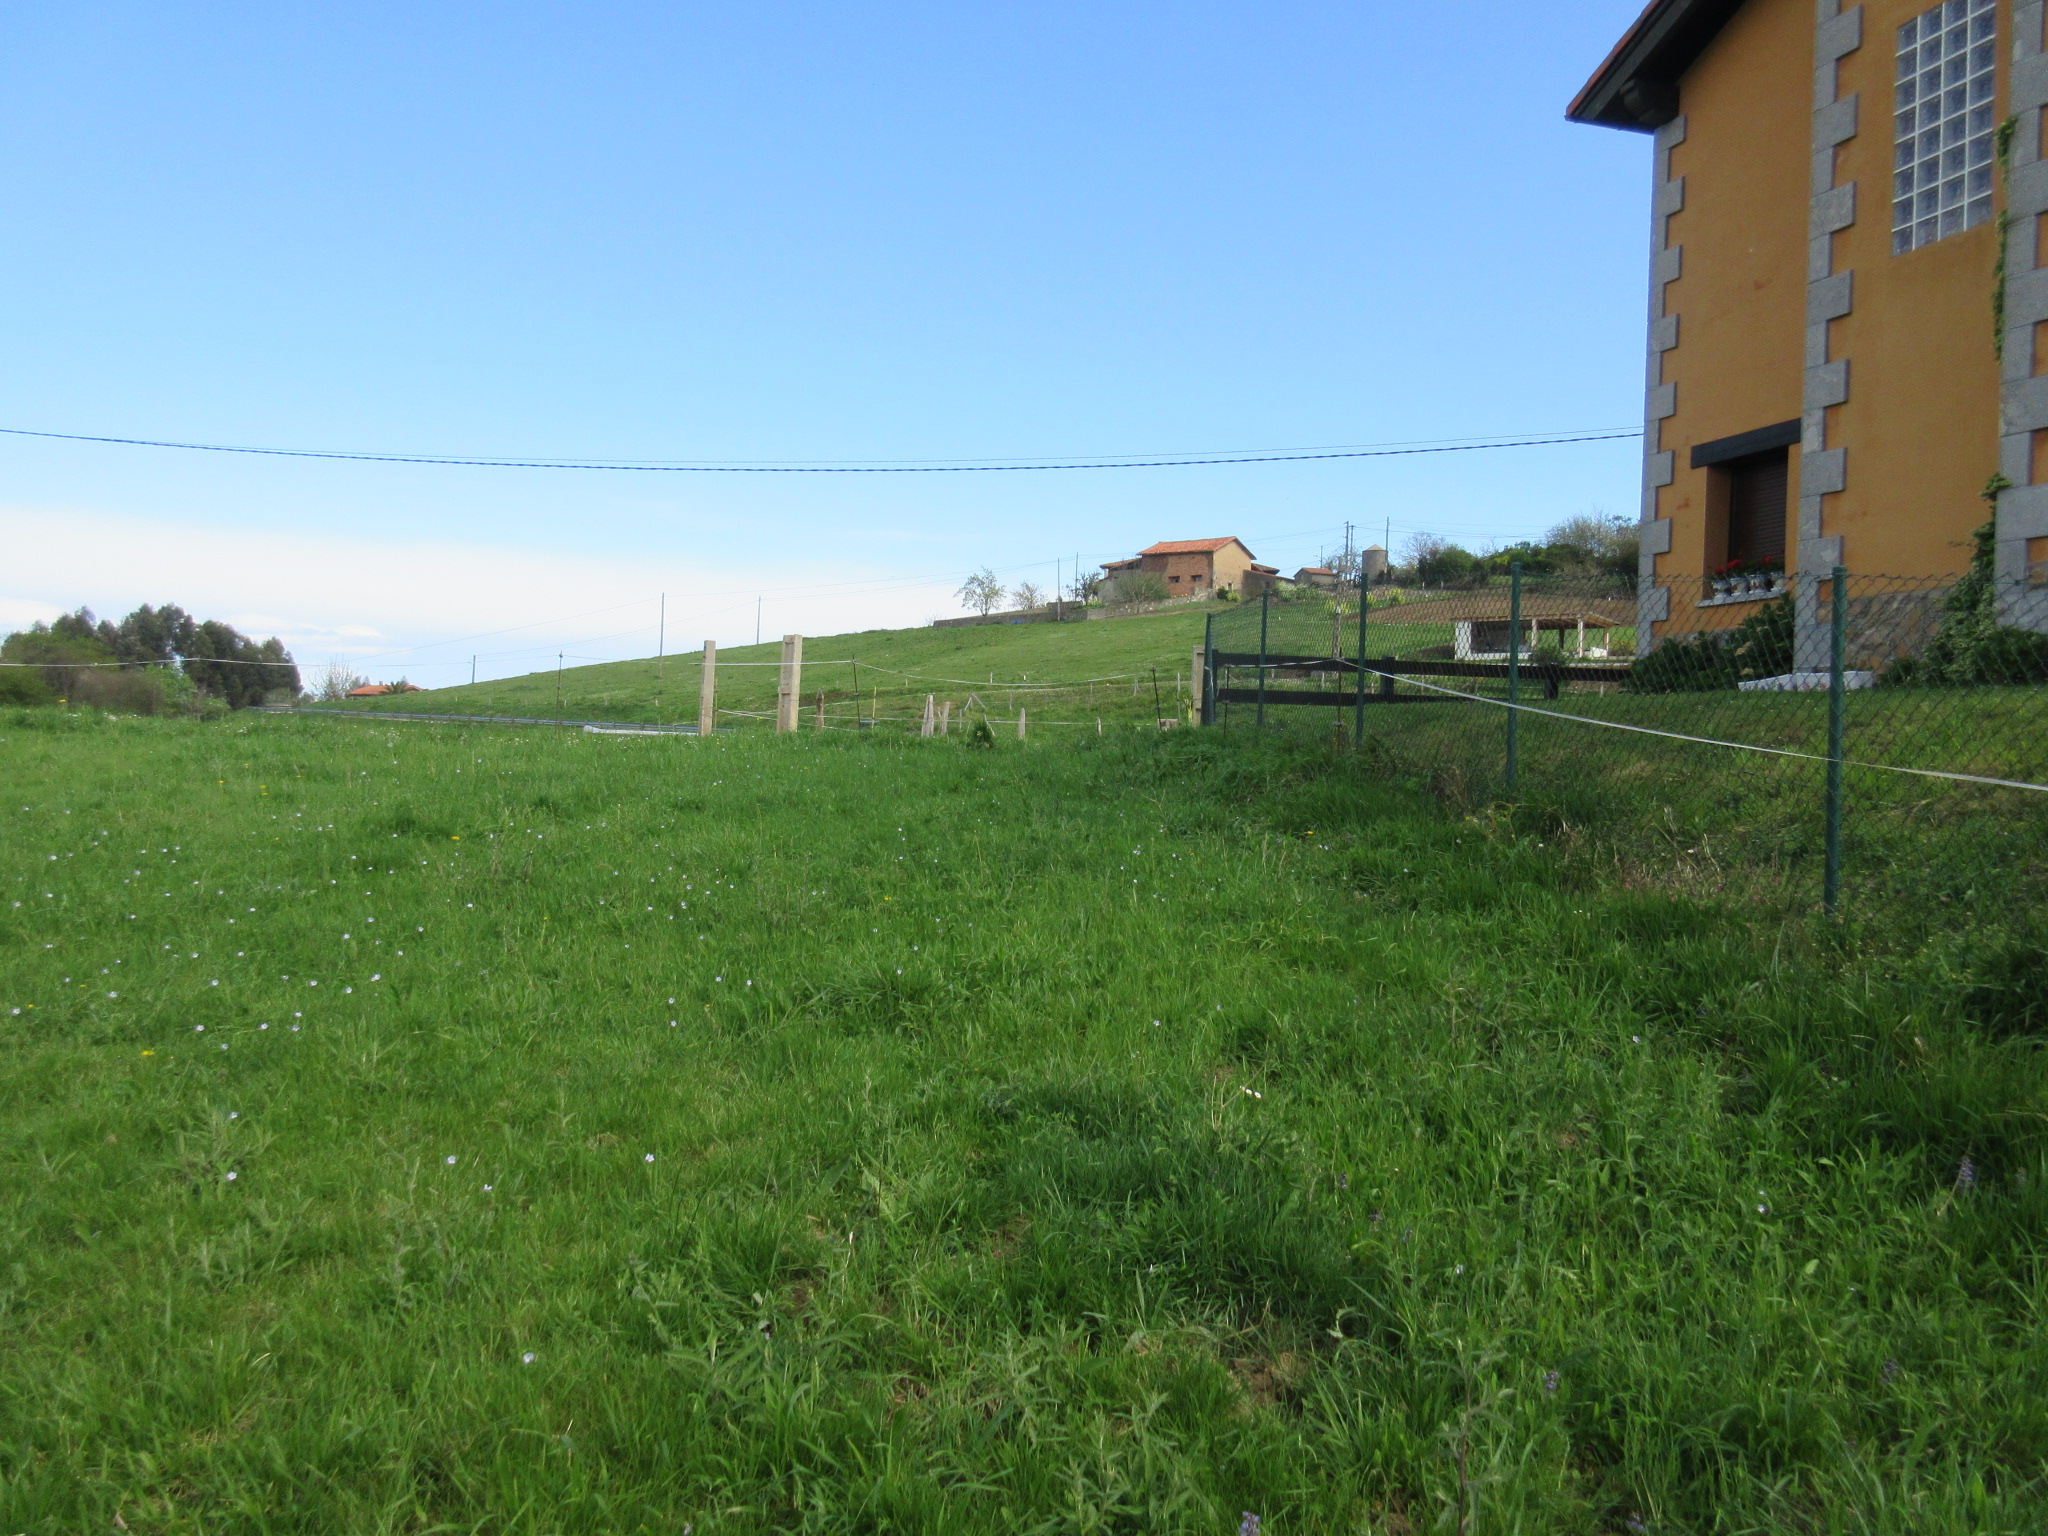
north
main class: Grassland
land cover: Grassland without tree/shrub cover
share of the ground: > 75 %
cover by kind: herbaceous plants 100 %
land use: Agriculture (excluding fallow land and kitchen gardens)
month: April
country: ES
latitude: 43.4419
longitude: -5.0844
